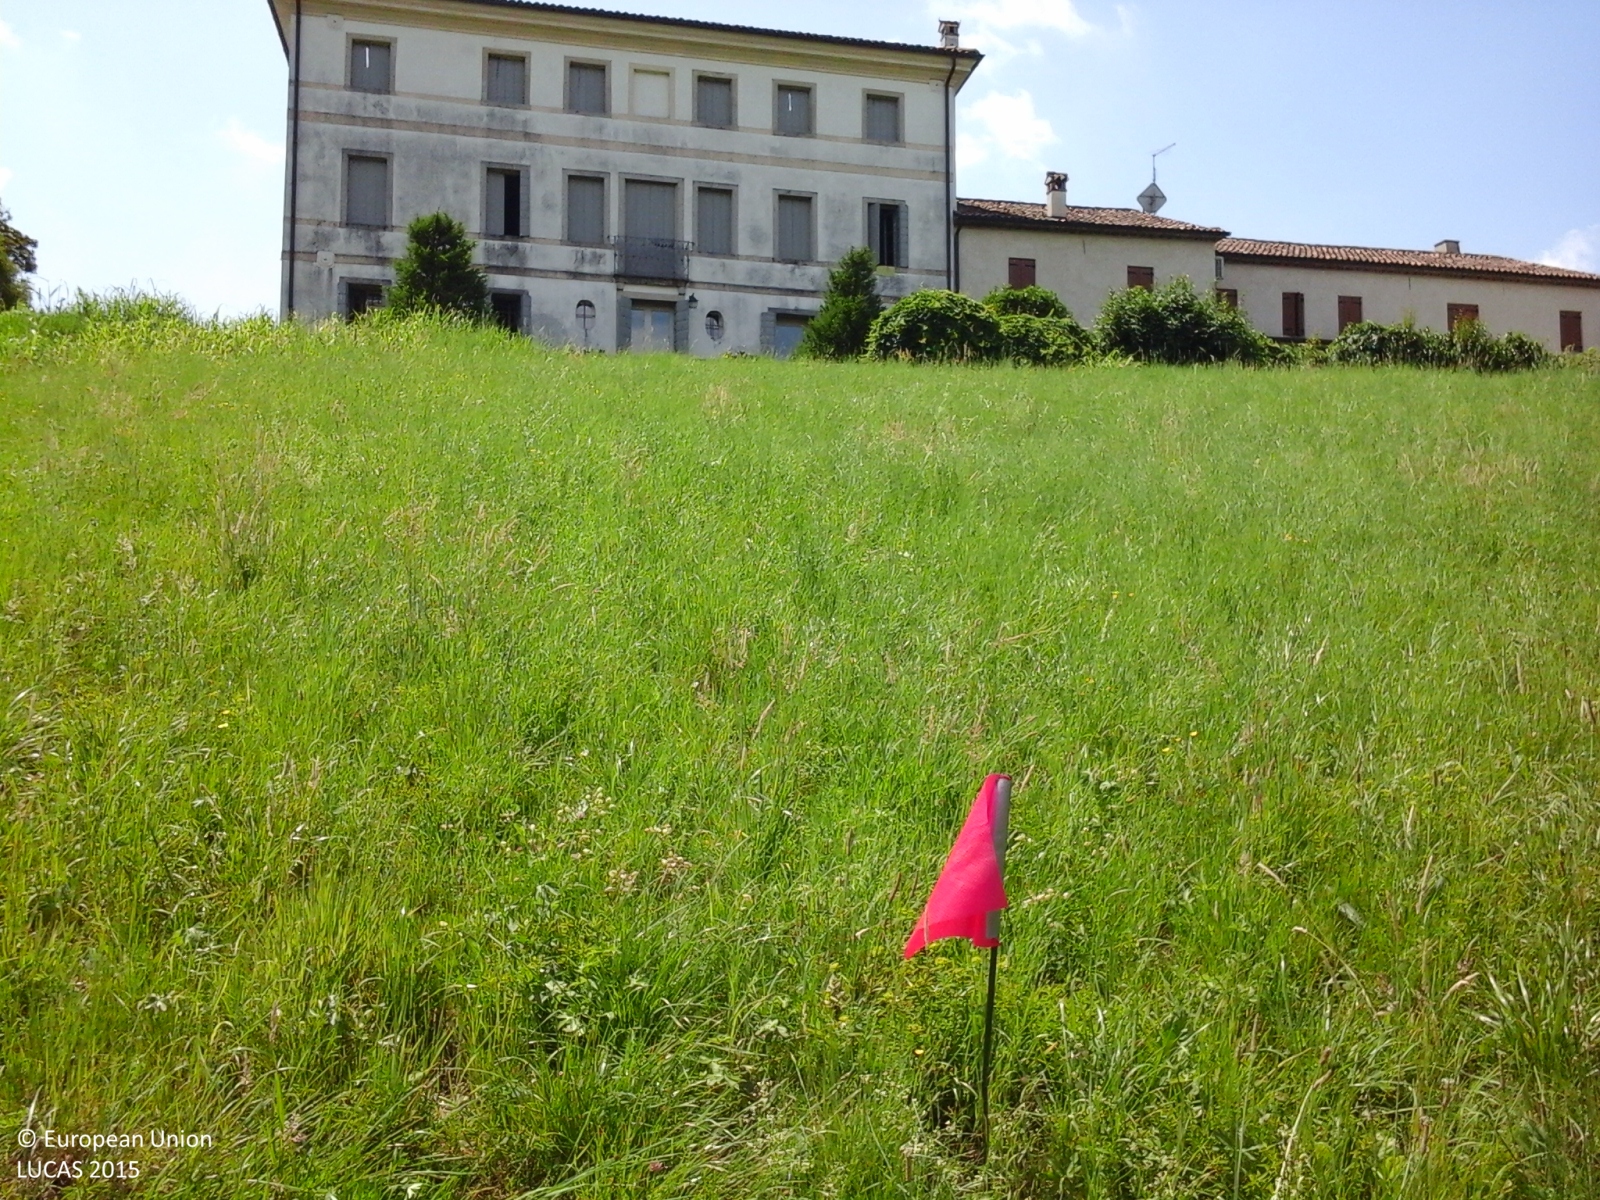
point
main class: Grassland
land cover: Grassland without tree/shrub cover
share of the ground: > 75 %
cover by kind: herbaceous plants 100 %
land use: Agriculture (excluding fallow land and kitchen gardens)
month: June
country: IT
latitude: 45.9293
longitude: 12.3310
